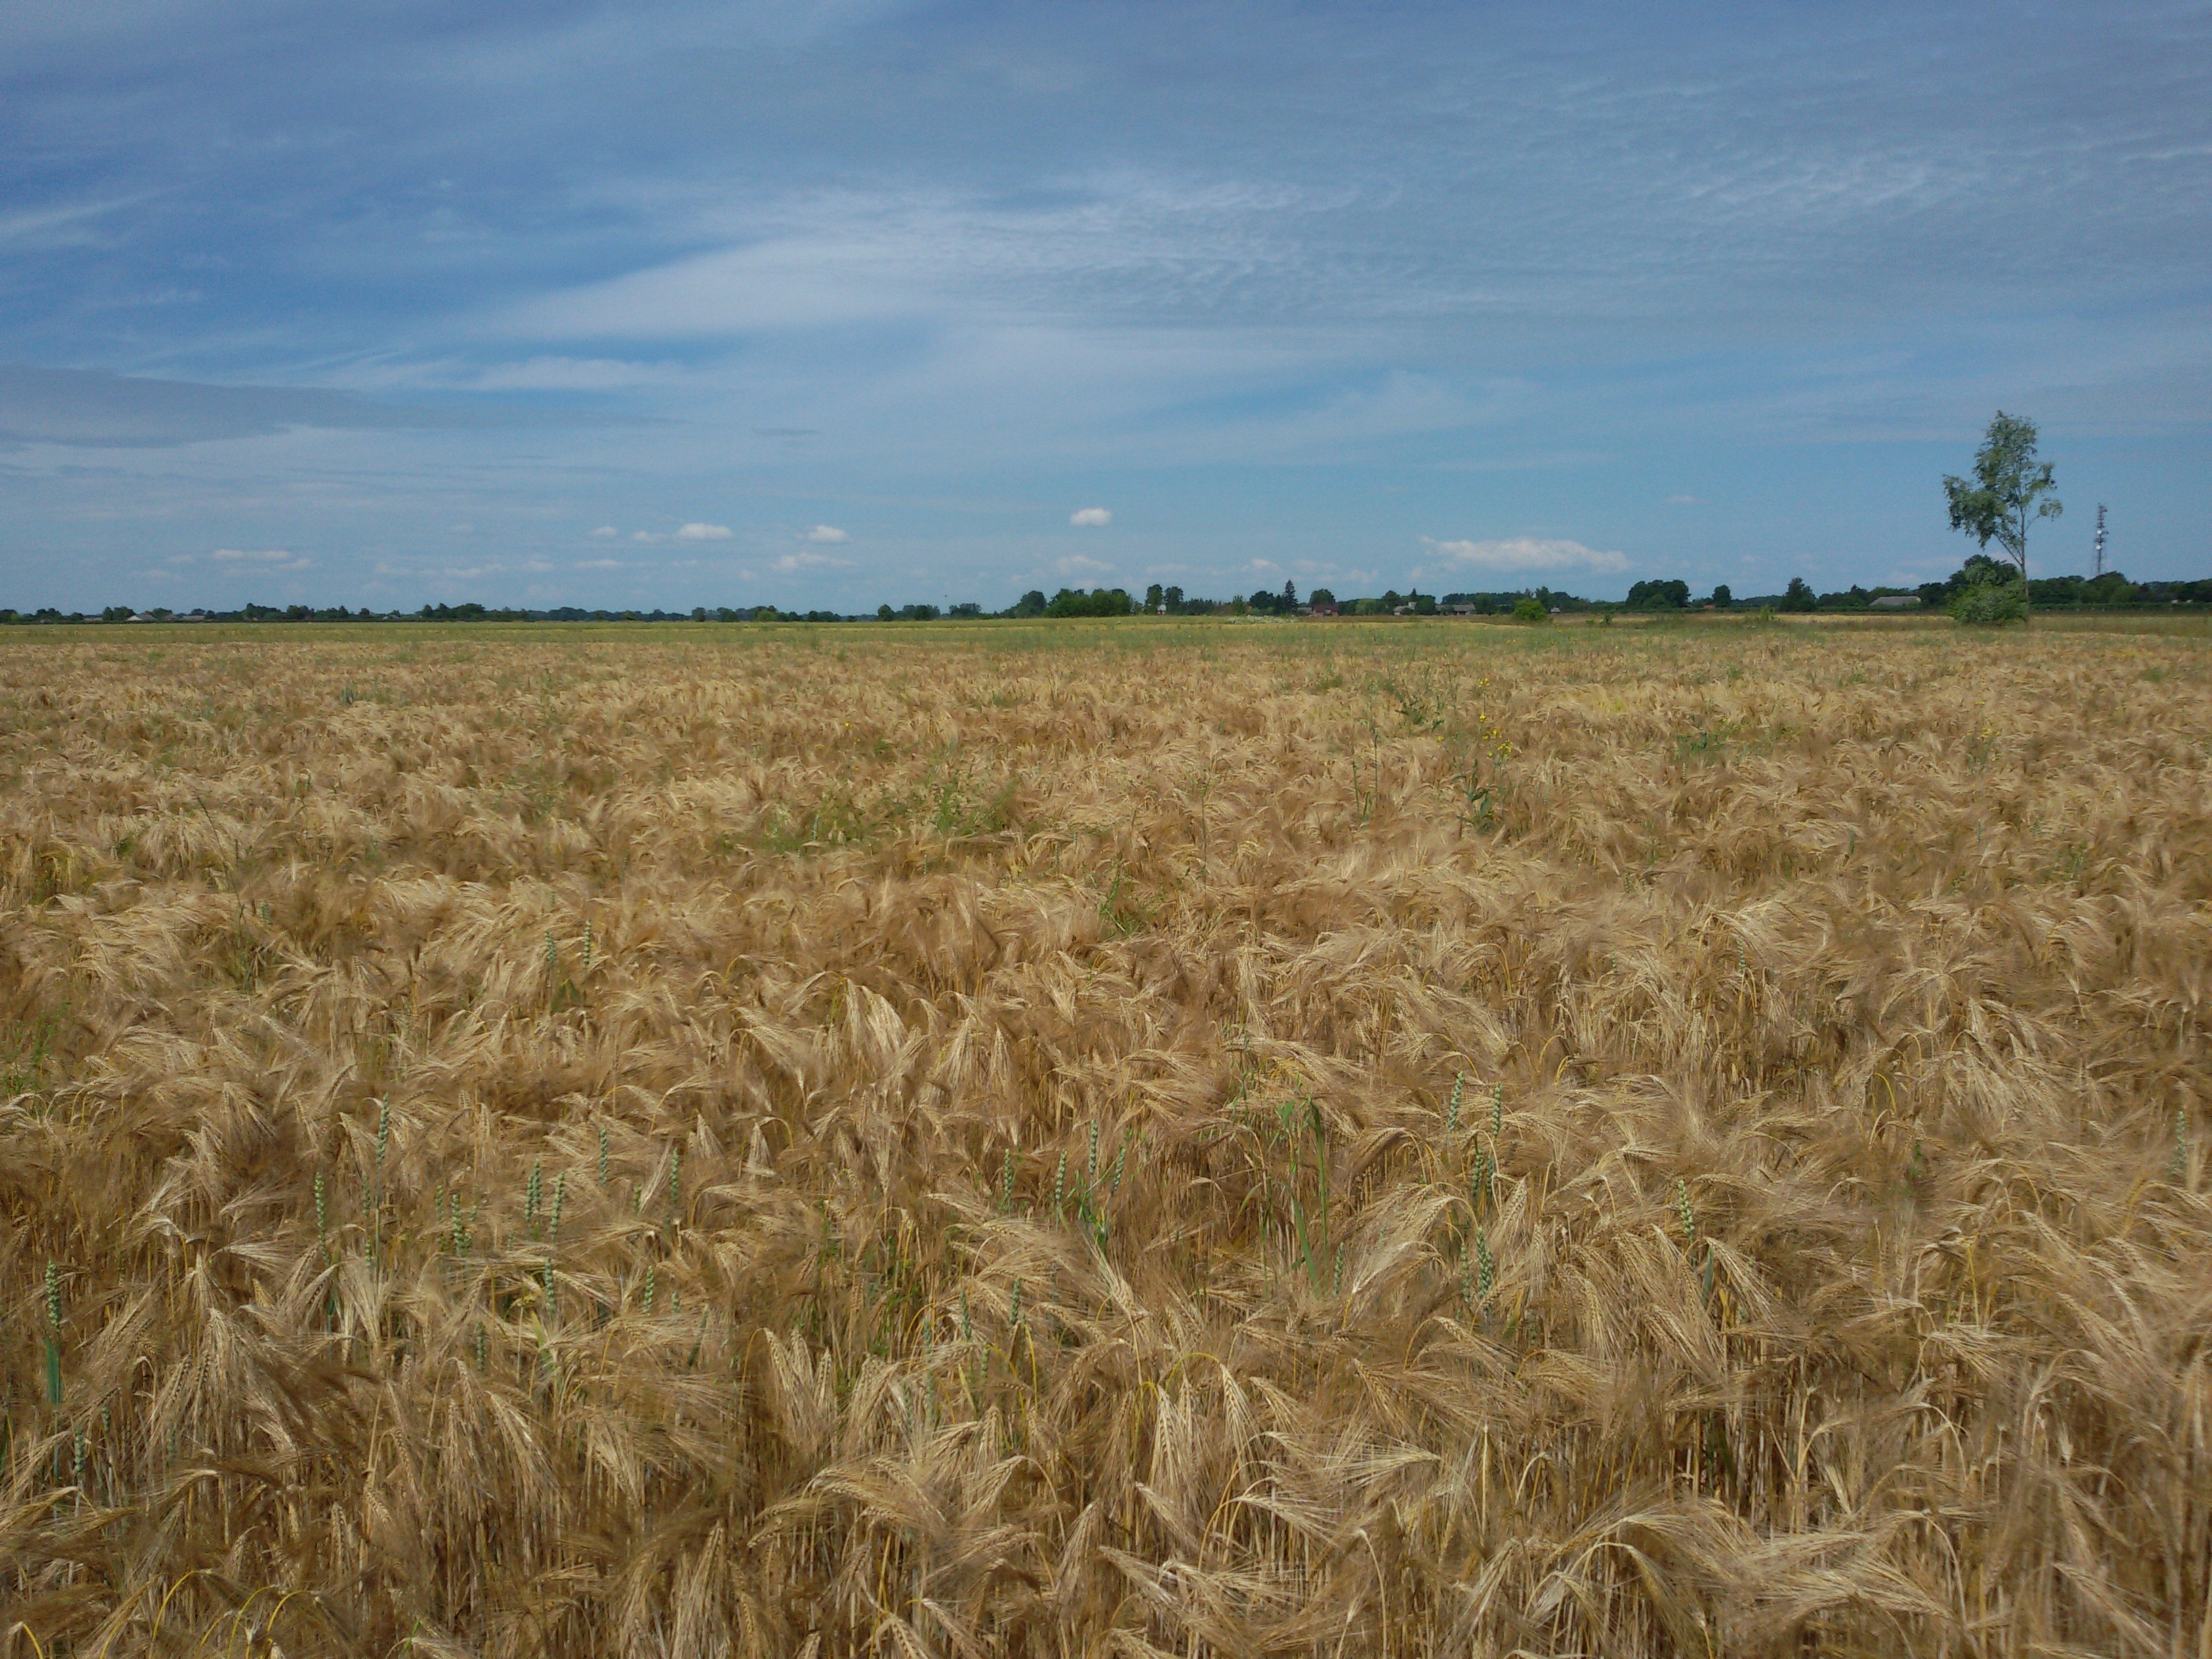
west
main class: Cropland
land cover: Barley
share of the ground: > 75 %
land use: Agriculture (excluding fallow land and kitchen gardens)
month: June
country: PL
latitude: 51.7278
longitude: 23.0335
